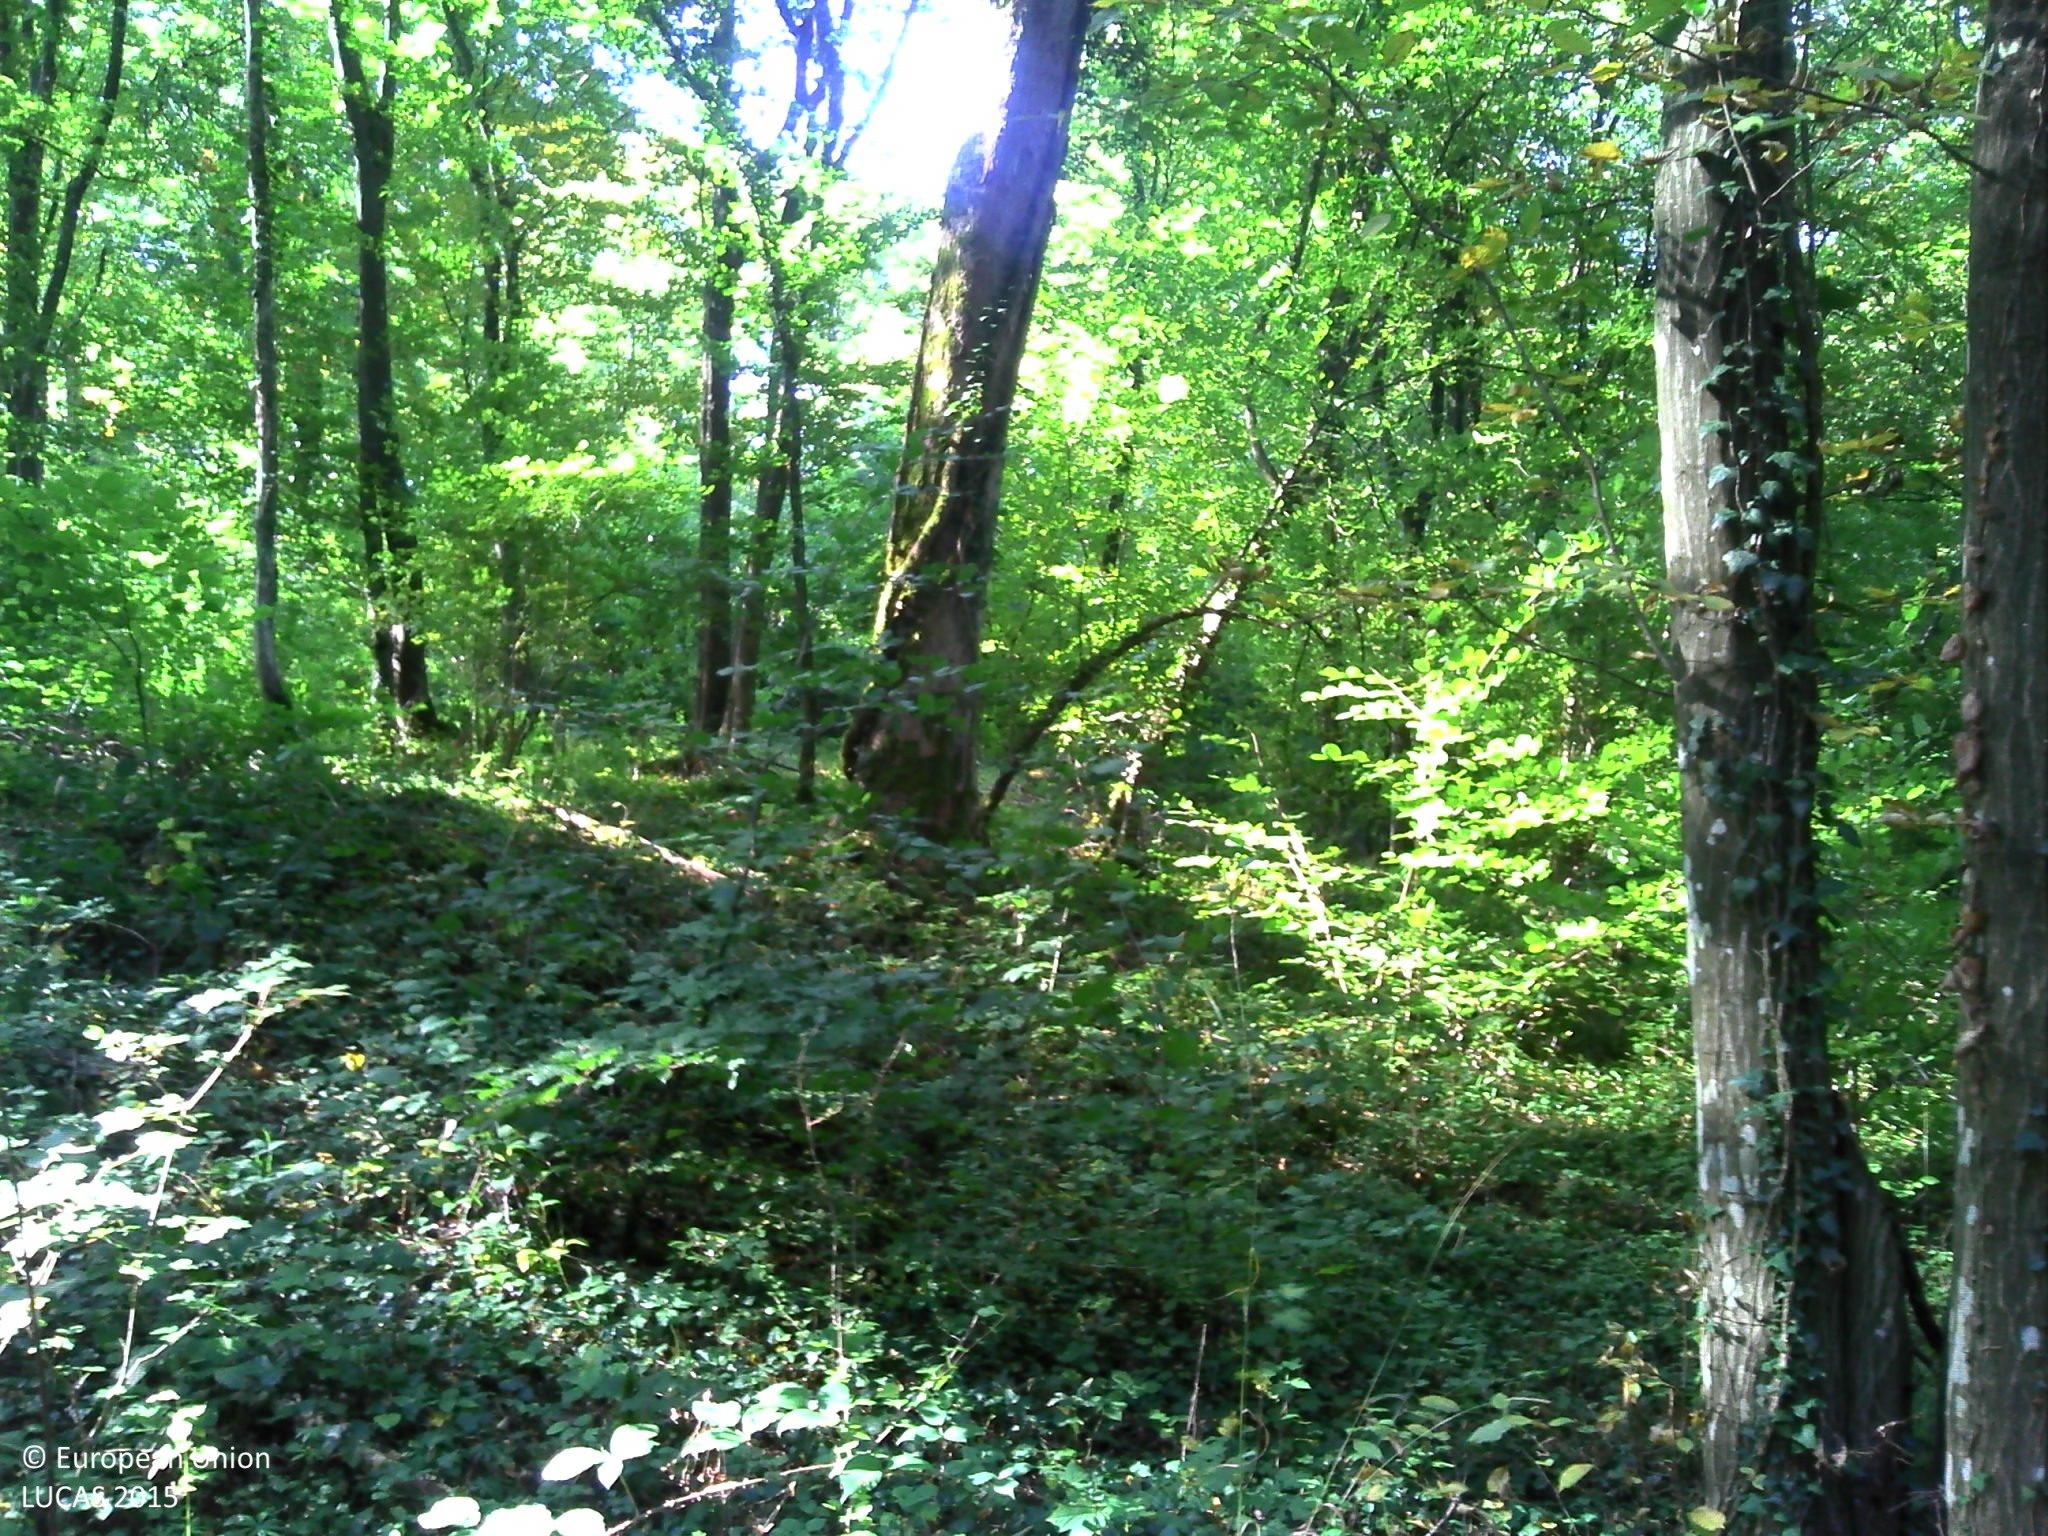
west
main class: Woodland
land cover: Broadleaved woodland
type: mesophytic deciduous forest
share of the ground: > 75 %
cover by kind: broadleaved forest trees 90 %, herbaceous plants 5 %, consolidated bare surface 5 %
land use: Forestry
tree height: > 5 m
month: September
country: FR
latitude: 49.2838
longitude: 5.9439
